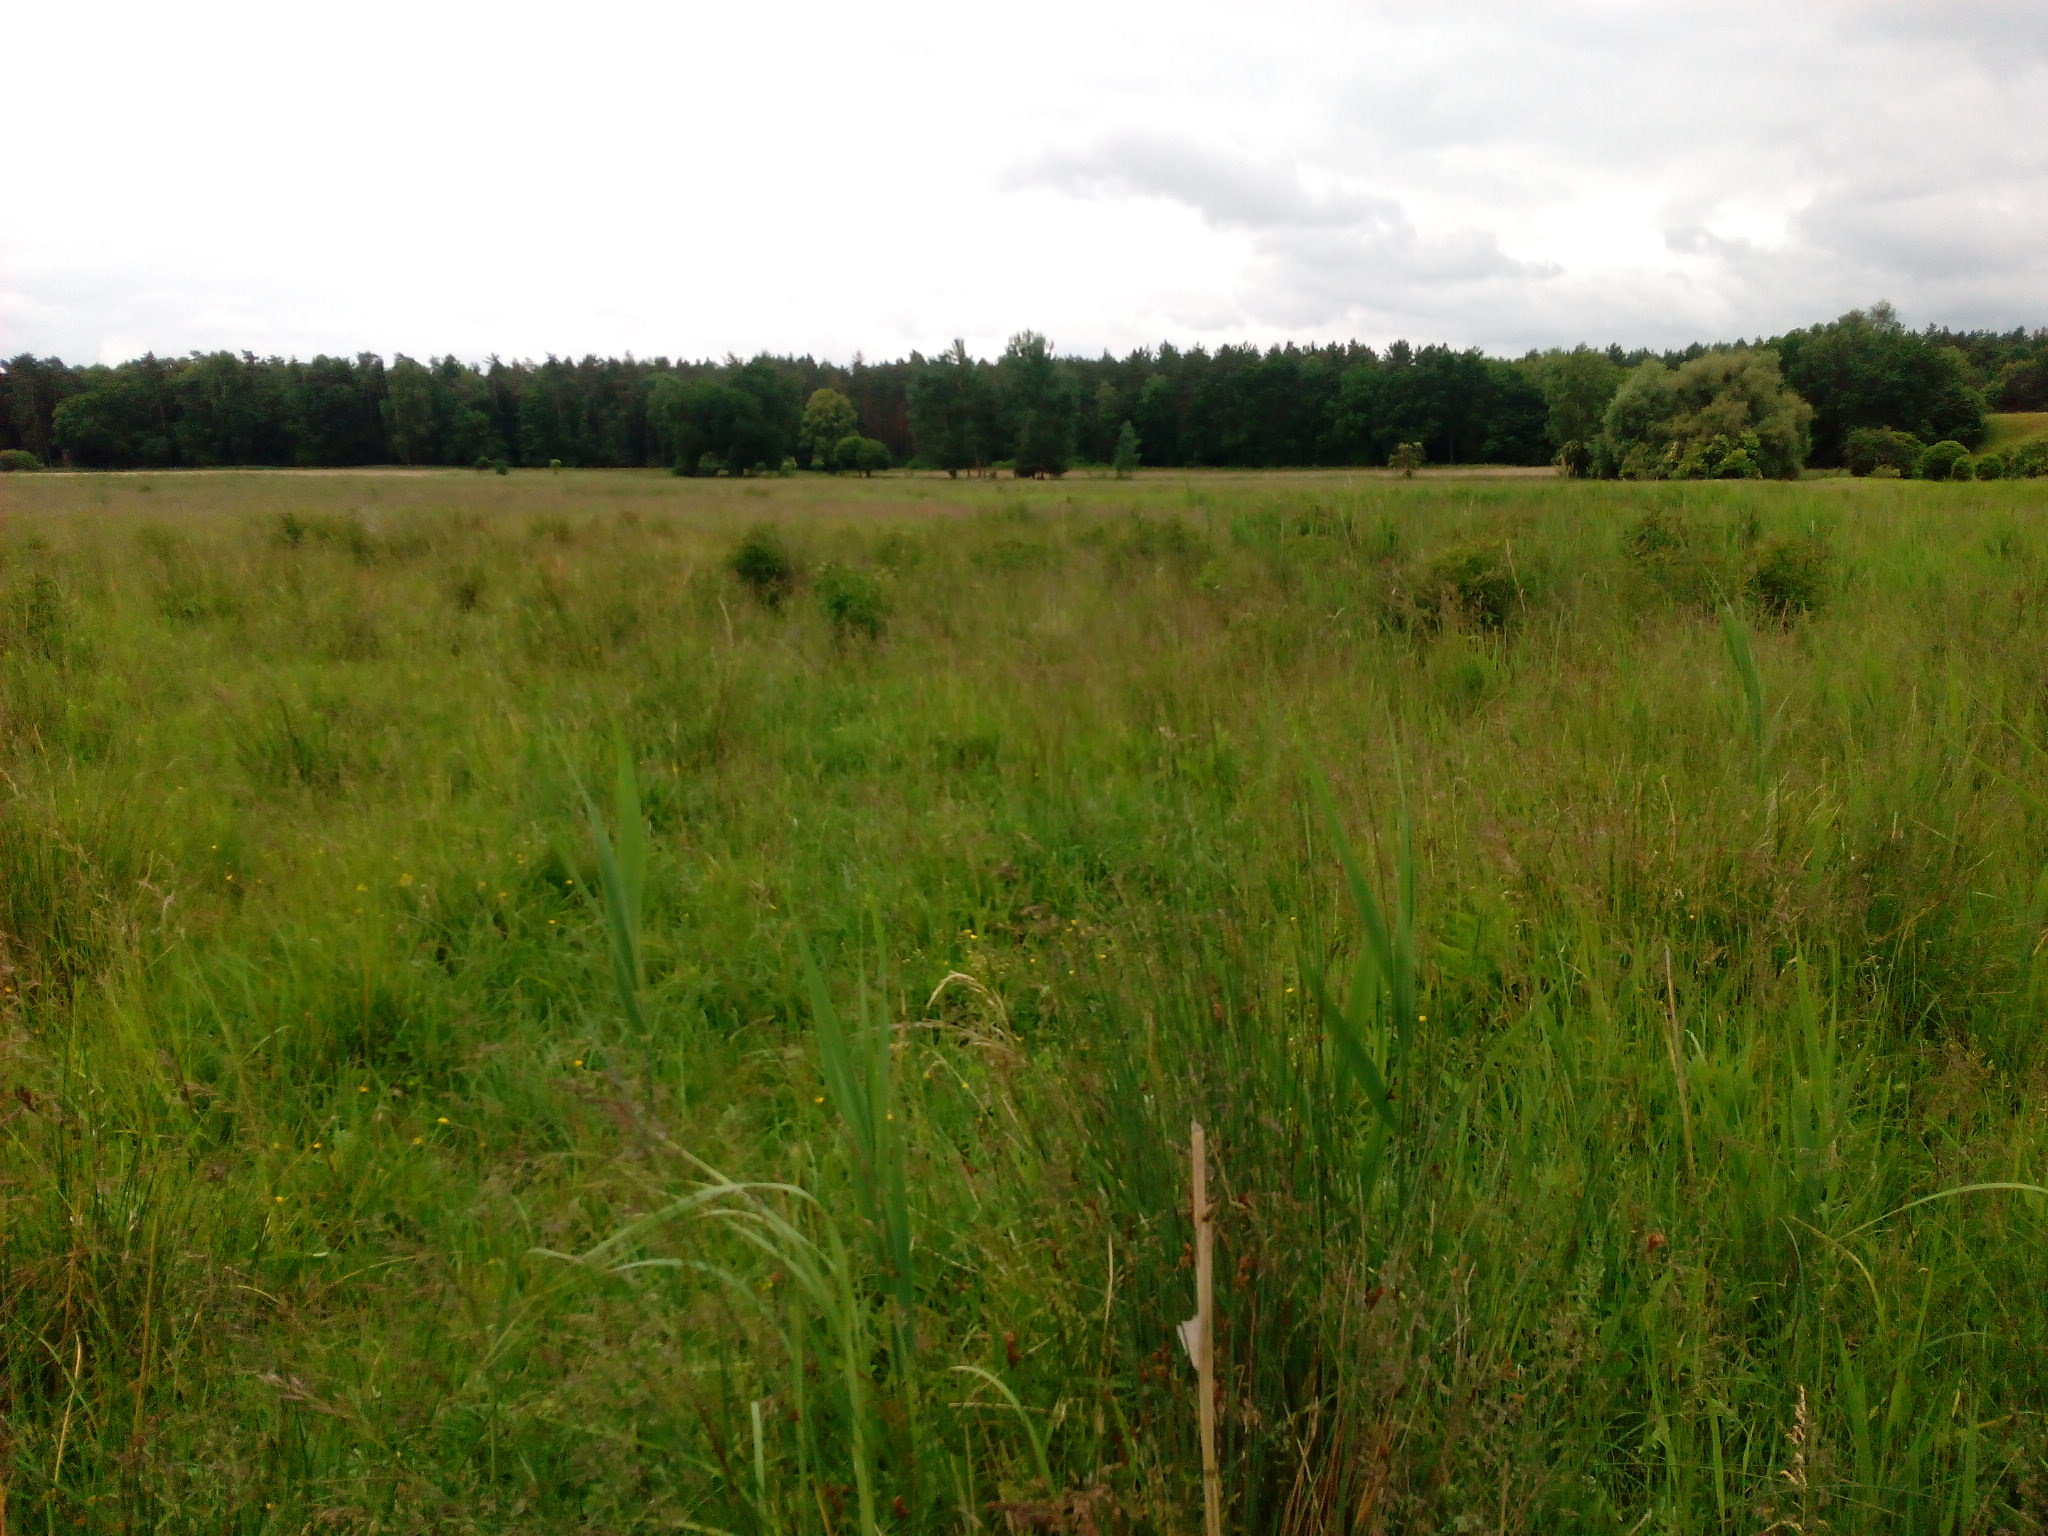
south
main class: Grassland
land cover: Grassland without tree/shrub cover
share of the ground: > 75 %
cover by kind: herbaceous plants 100 %
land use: Agriculture (excluding fallow land and kitchen gardens)
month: June
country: DE
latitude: 53.1084
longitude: 13.1815
